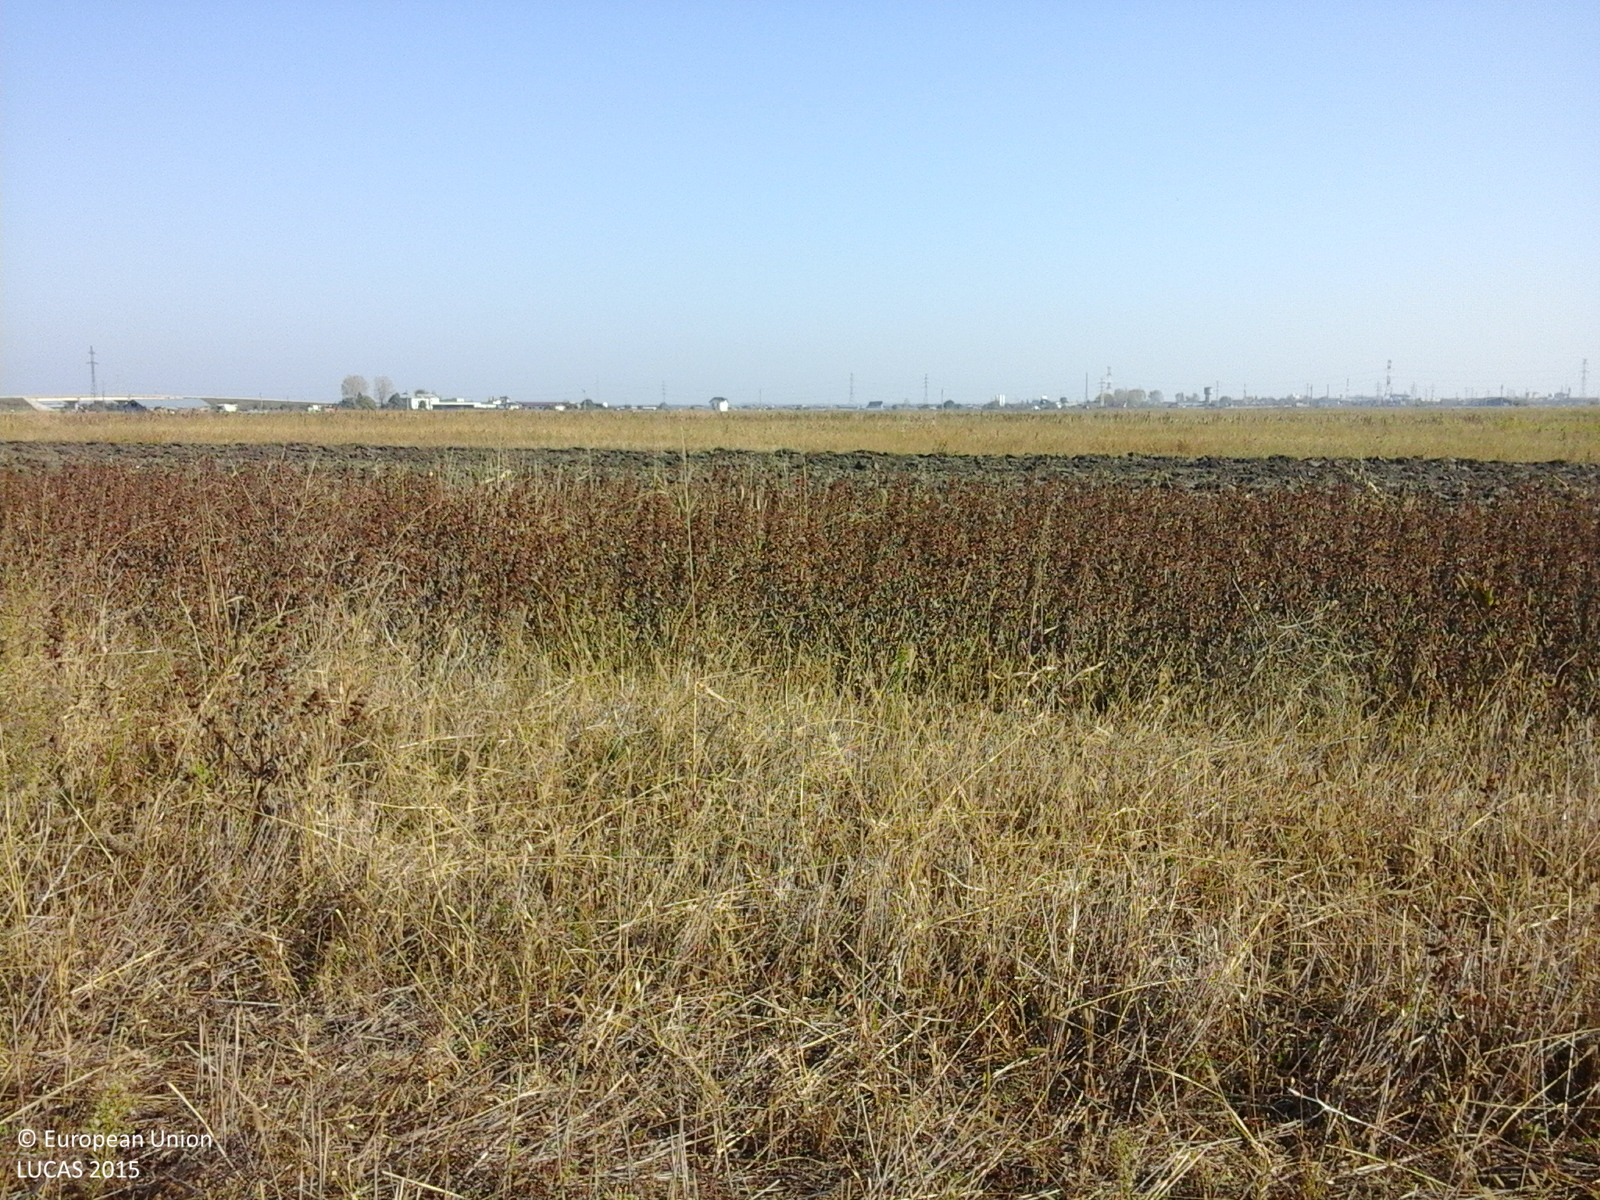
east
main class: Cropland
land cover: Maize
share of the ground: 25 - 50 %
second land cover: Spontaneously vegetated surfaces
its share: > 75 %
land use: Agriculture (excluding fallow land and kitchen gardens)
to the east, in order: Maize; Spontaneously vegetated surfaces; Other bare soil; Sunflower; Spontaneously vegetated surfaces; Sunflower; Other bare soil; Sunflower
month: October
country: RO
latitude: 45.7263
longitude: 27.1448
